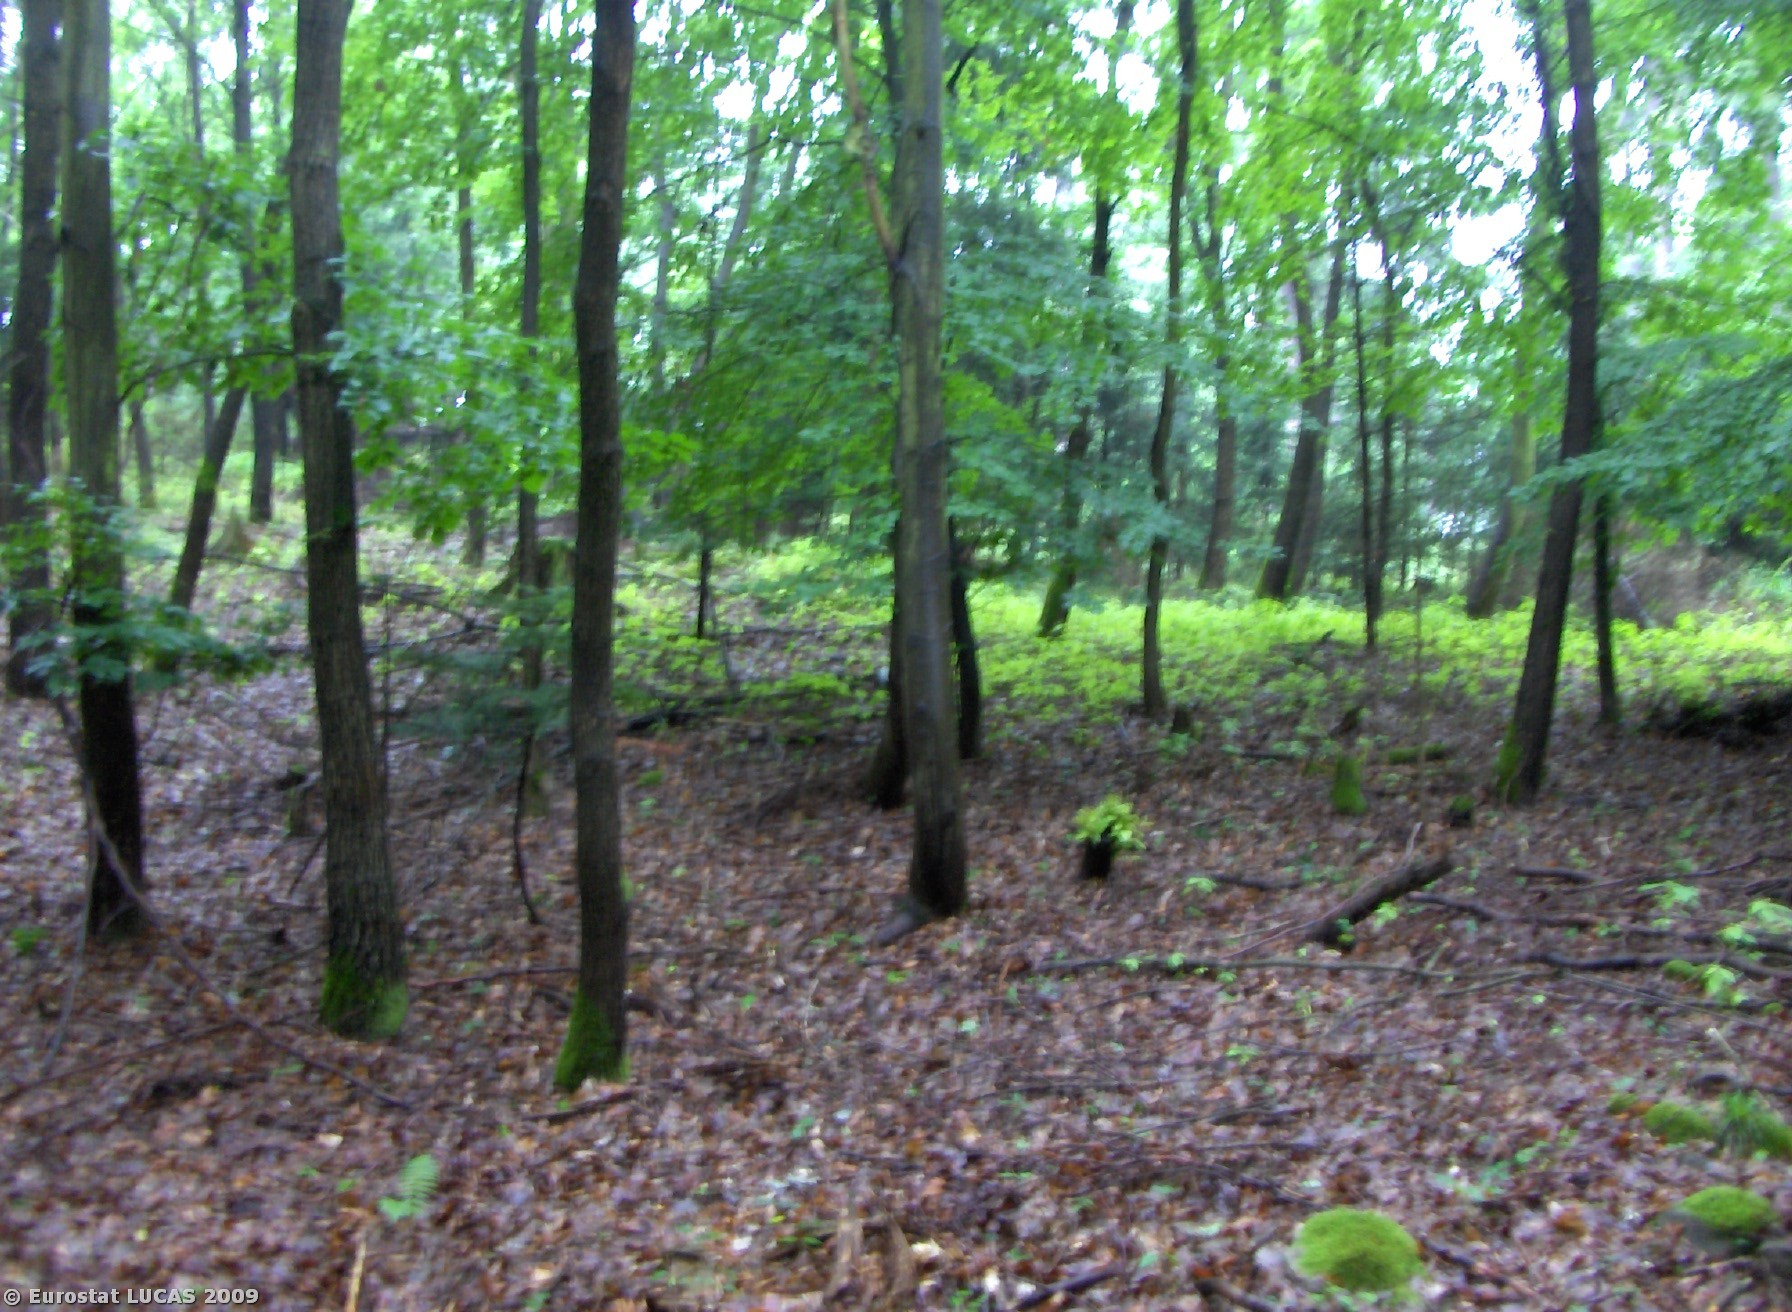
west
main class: Woodland
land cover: Broadleaved woodland
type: beech forest
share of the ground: > 75 %
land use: Forestry
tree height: > 5 m
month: June
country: CZ
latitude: 49.7106
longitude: 14.2030
